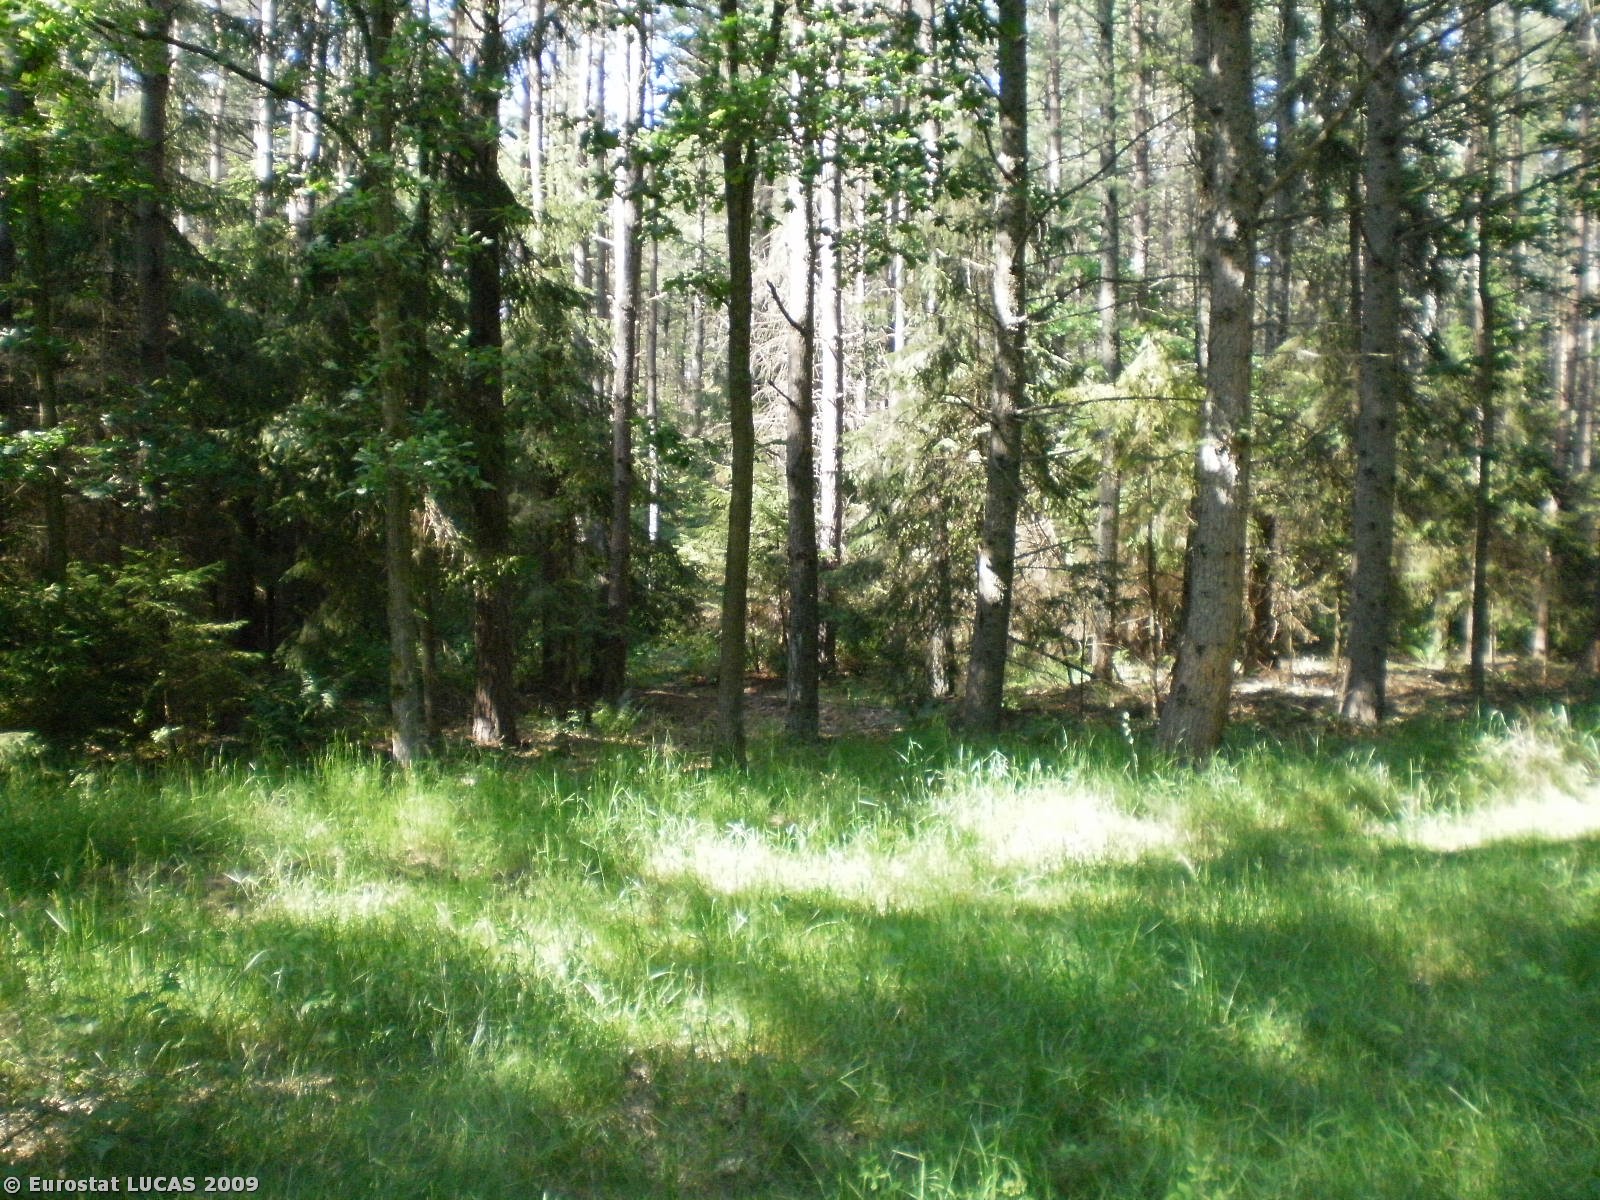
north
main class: Woodland
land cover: Coniferous woodland
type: hemiboreal forest and nemoral coniferous forest and mixed broadleaved-coniferous forest
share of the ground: > 75 %
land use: Forestry
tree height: > 5 m
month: June
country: PL
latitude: 54.4271
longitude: 17.3003
